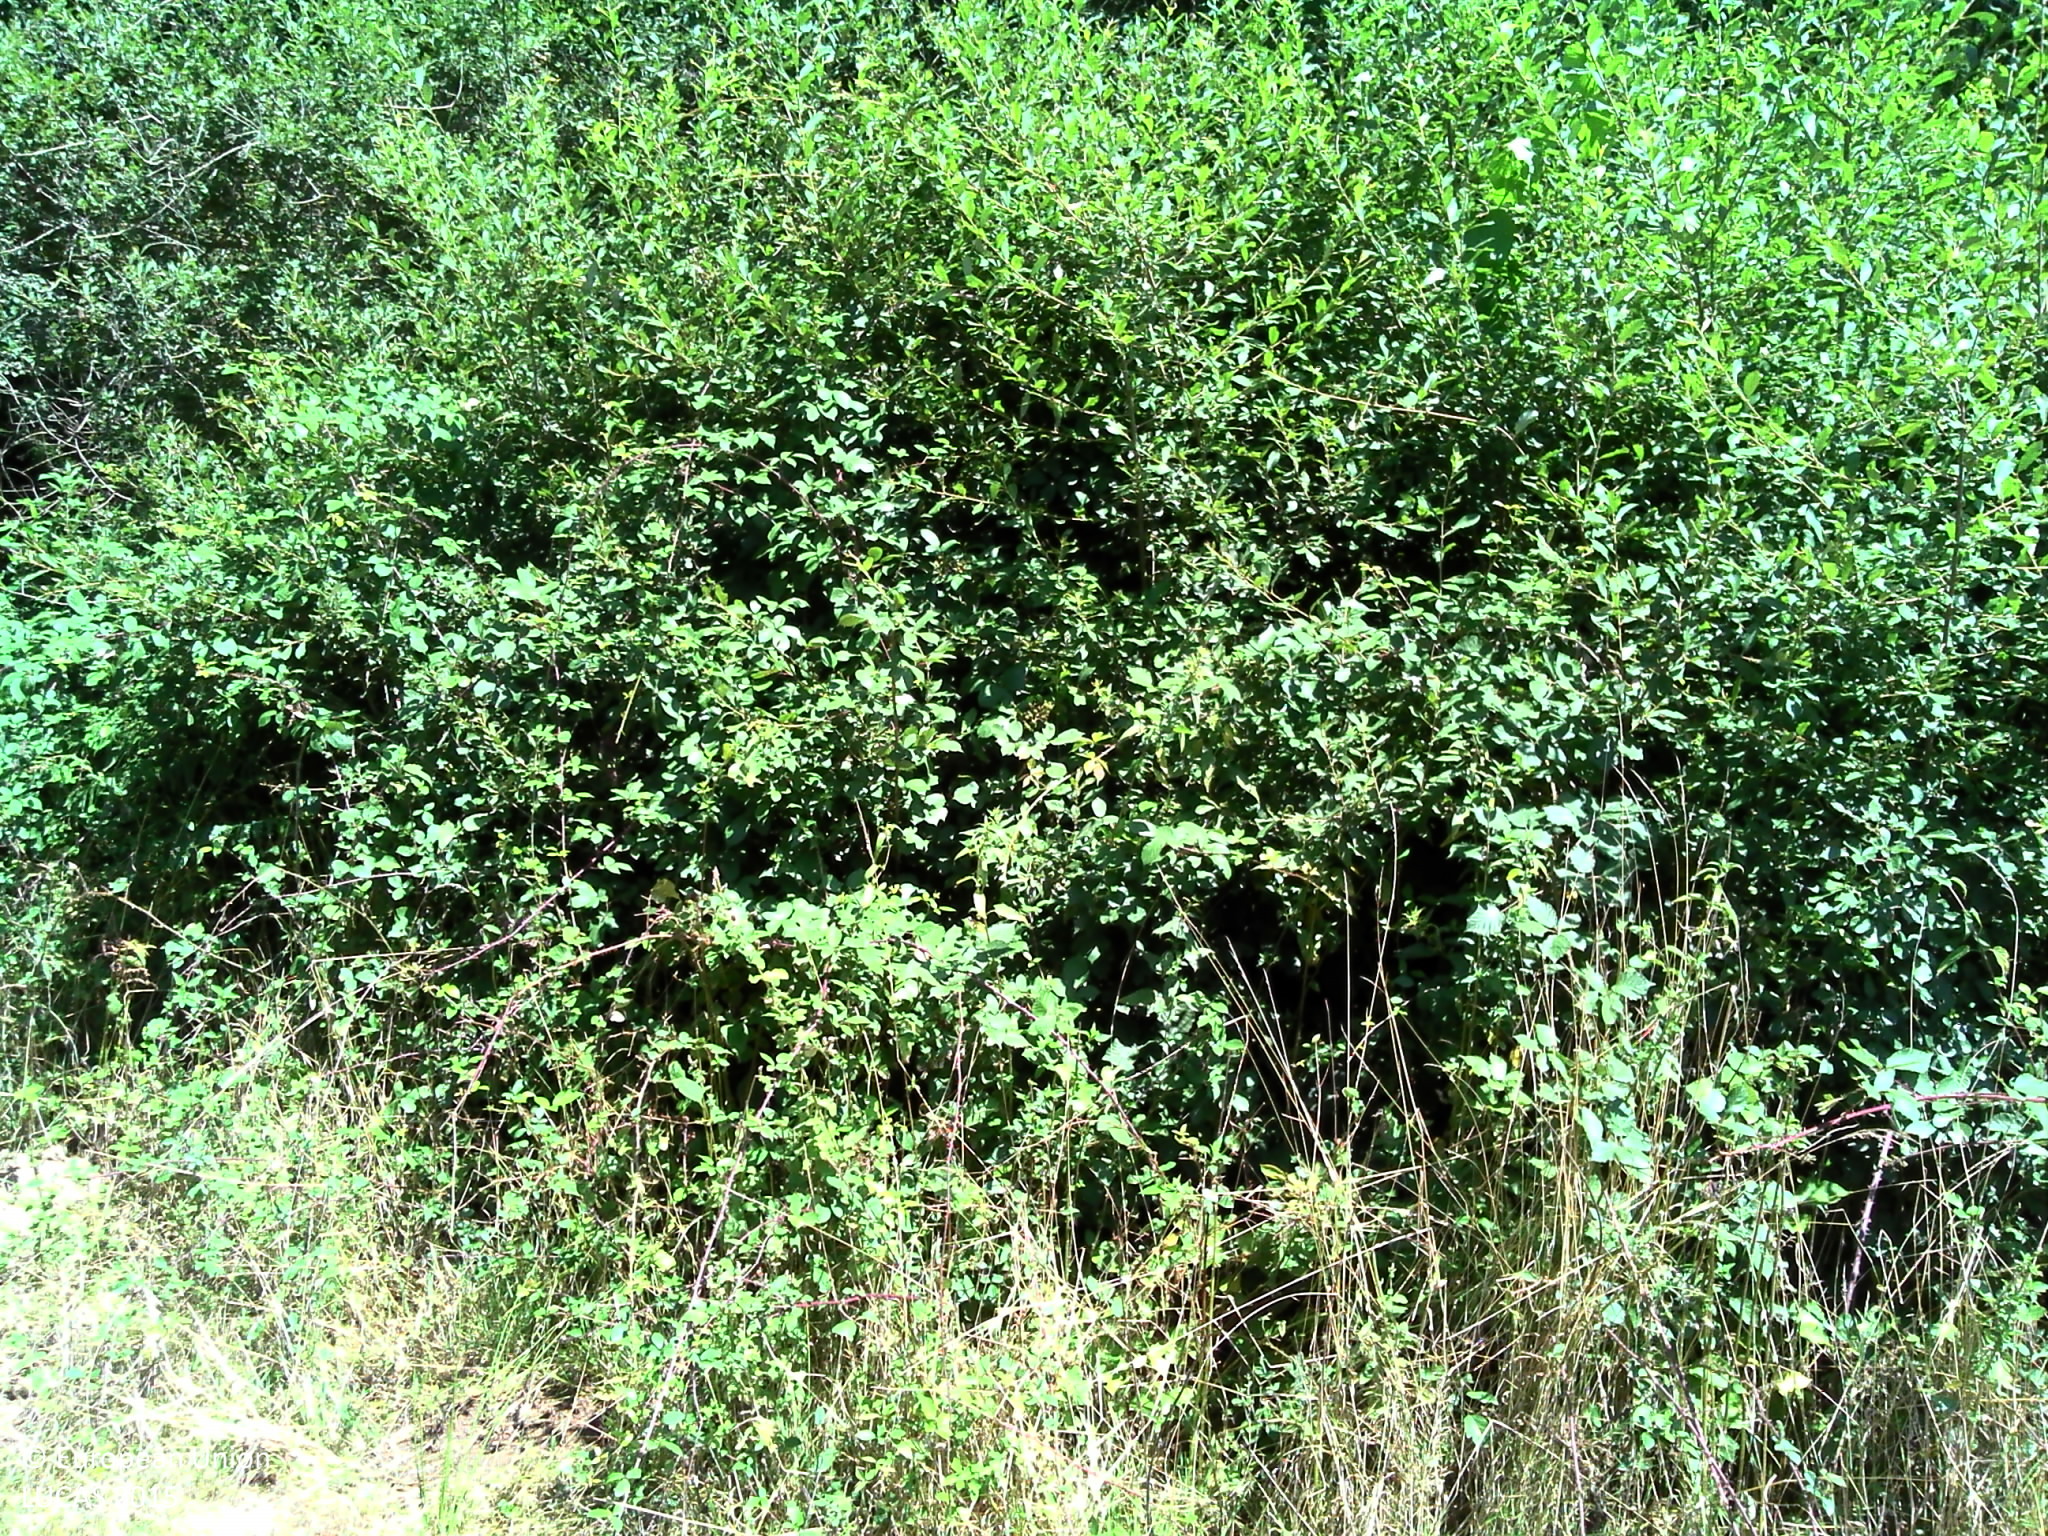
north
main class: Grassland
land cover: Grassland without tree/shrub cover
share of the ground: > 75 %
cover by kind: herbaceous plants 100 %
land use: Agriculture (excluding fallow land and kitchen gardens)
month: August
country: FR
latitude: 43.9784
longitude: 2.6126
